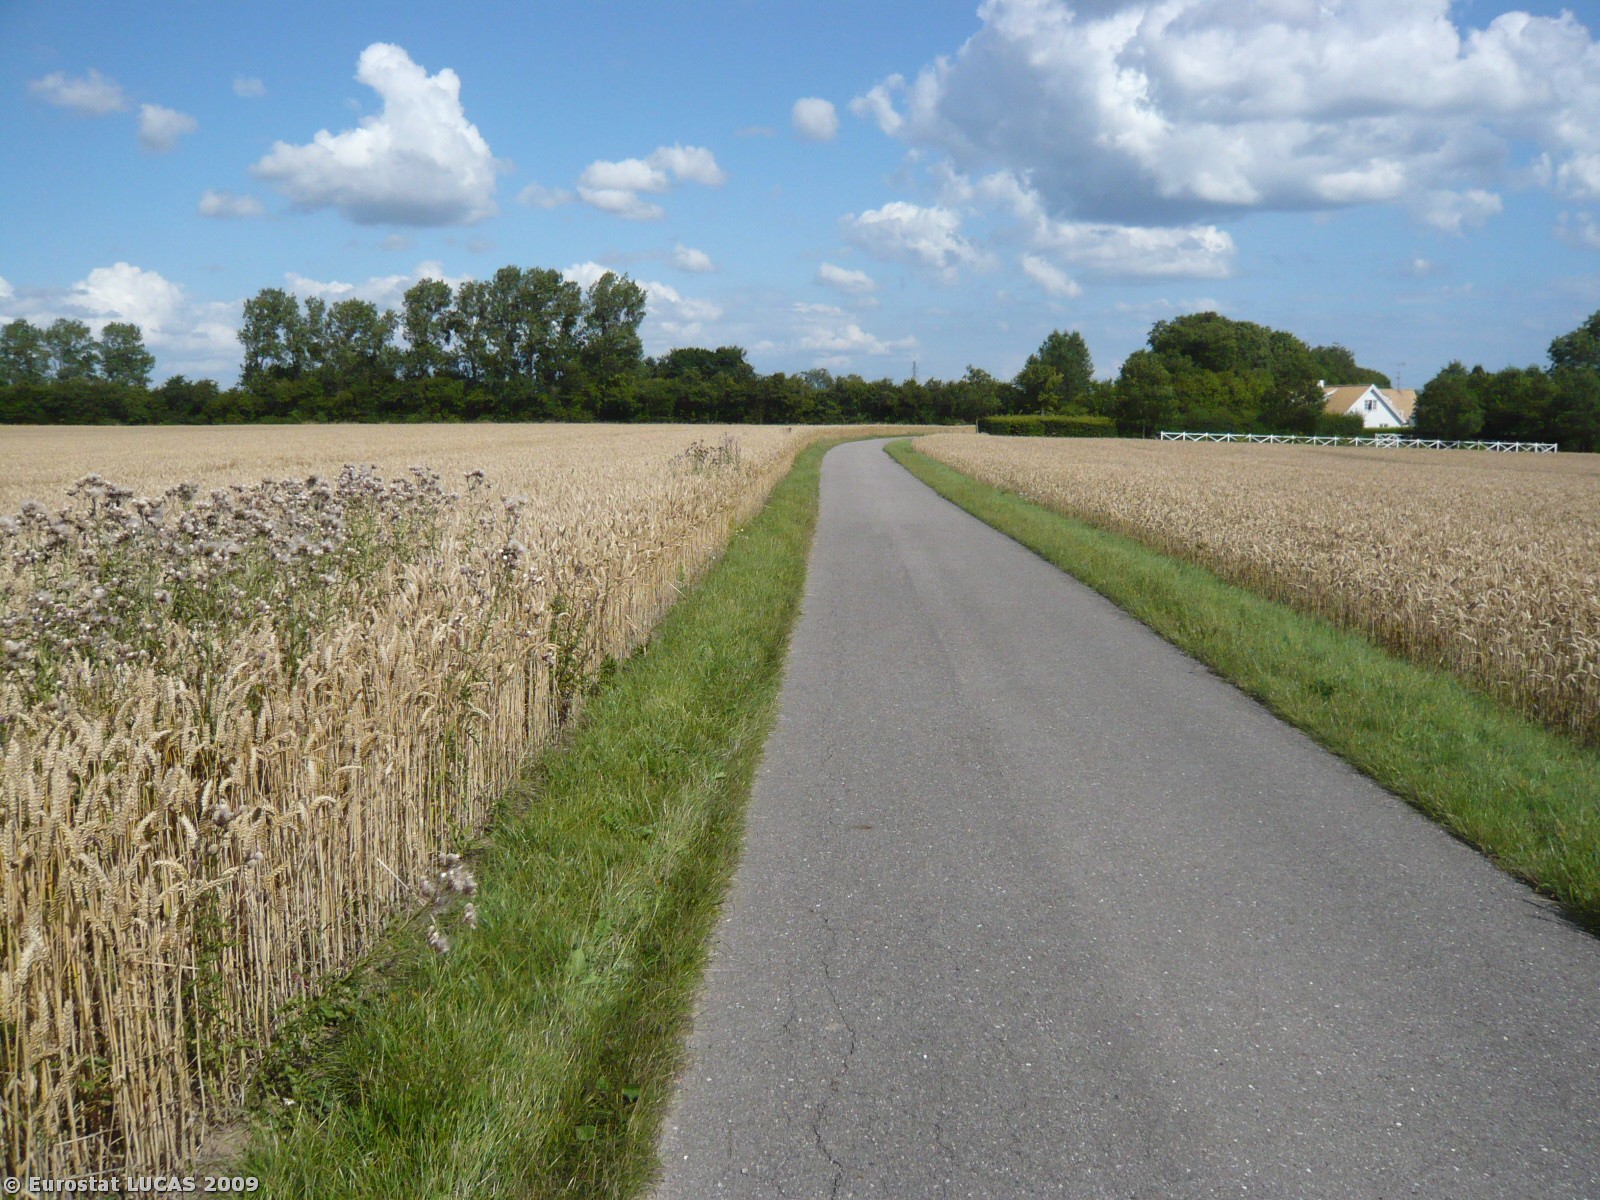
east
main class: Cropland
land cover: Common wheat
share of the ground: > 75 %
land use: Agriculture (excluding fallow land and kitchen gardens)
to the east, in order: Common wheat; Broadleaved woodland; Arable land (only in case pi)
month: July
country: DK
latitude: 55.5760
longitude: 12.1712
